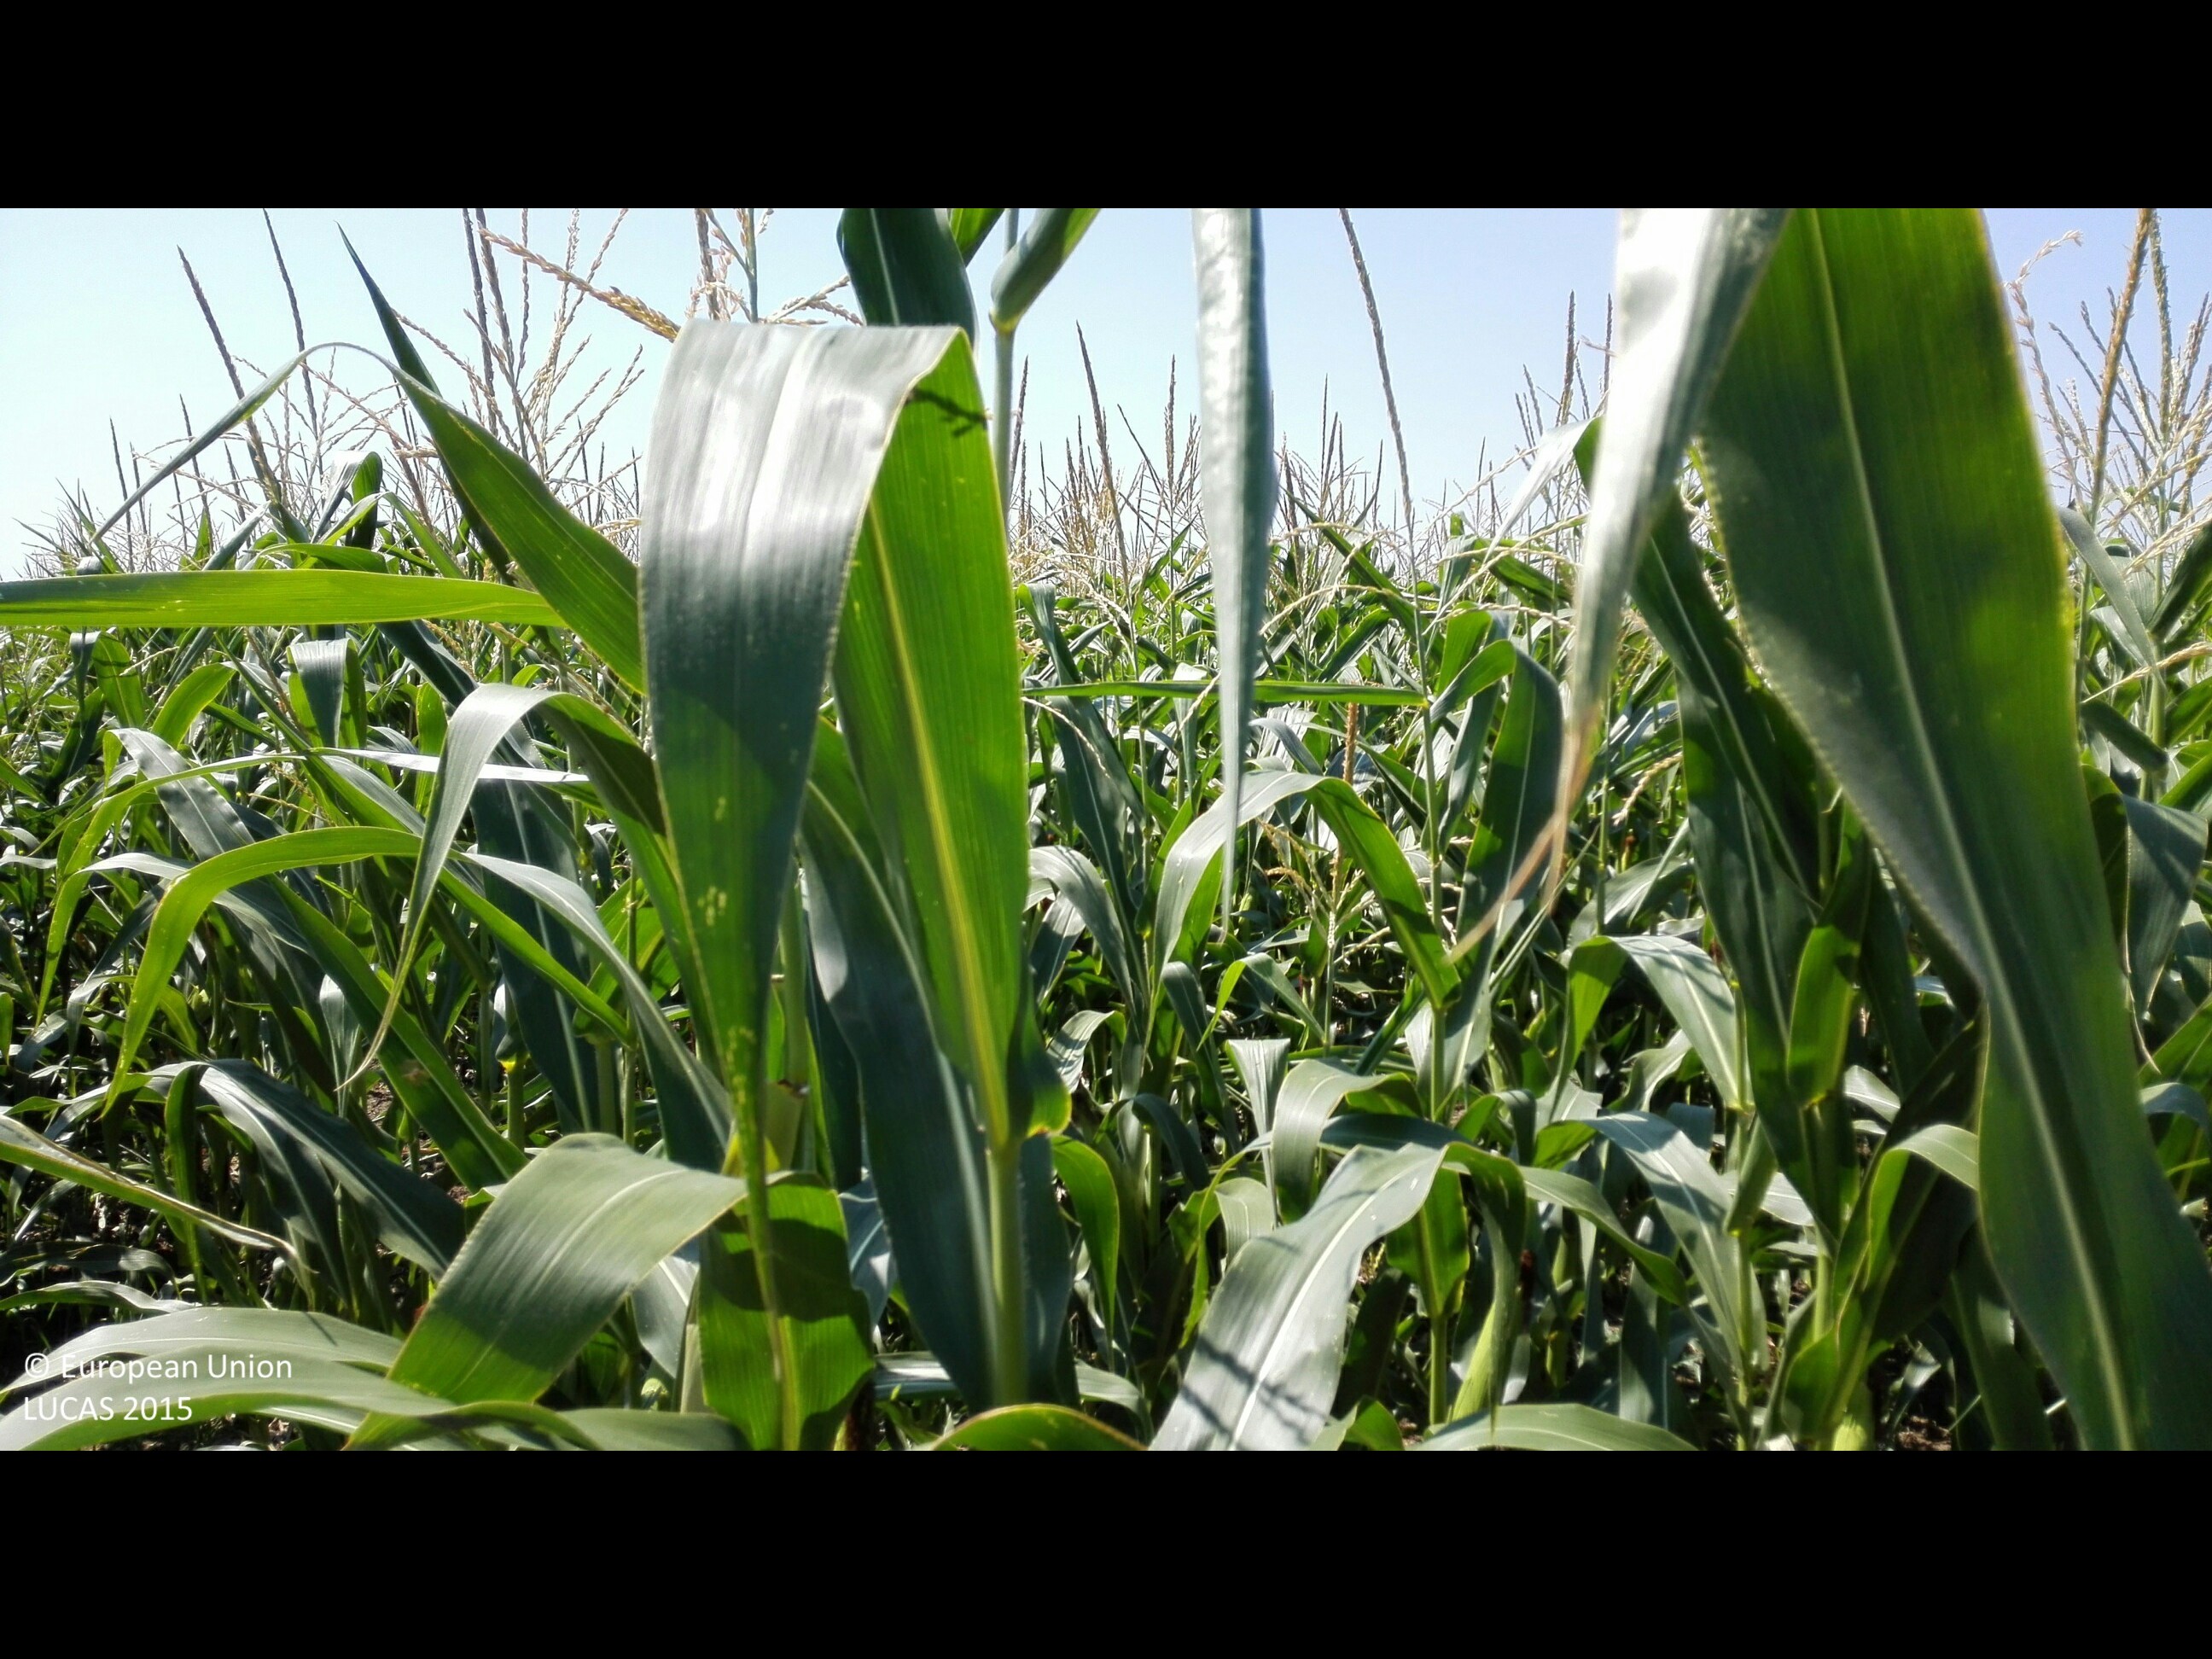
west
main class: Cropland
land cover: Maize
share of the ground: > 75 %
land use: Agriculture (excluding fallow land and kitchen gardens)
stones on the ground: < 10 %
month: July
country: HU
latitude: 47.2249
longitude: 21.2775
